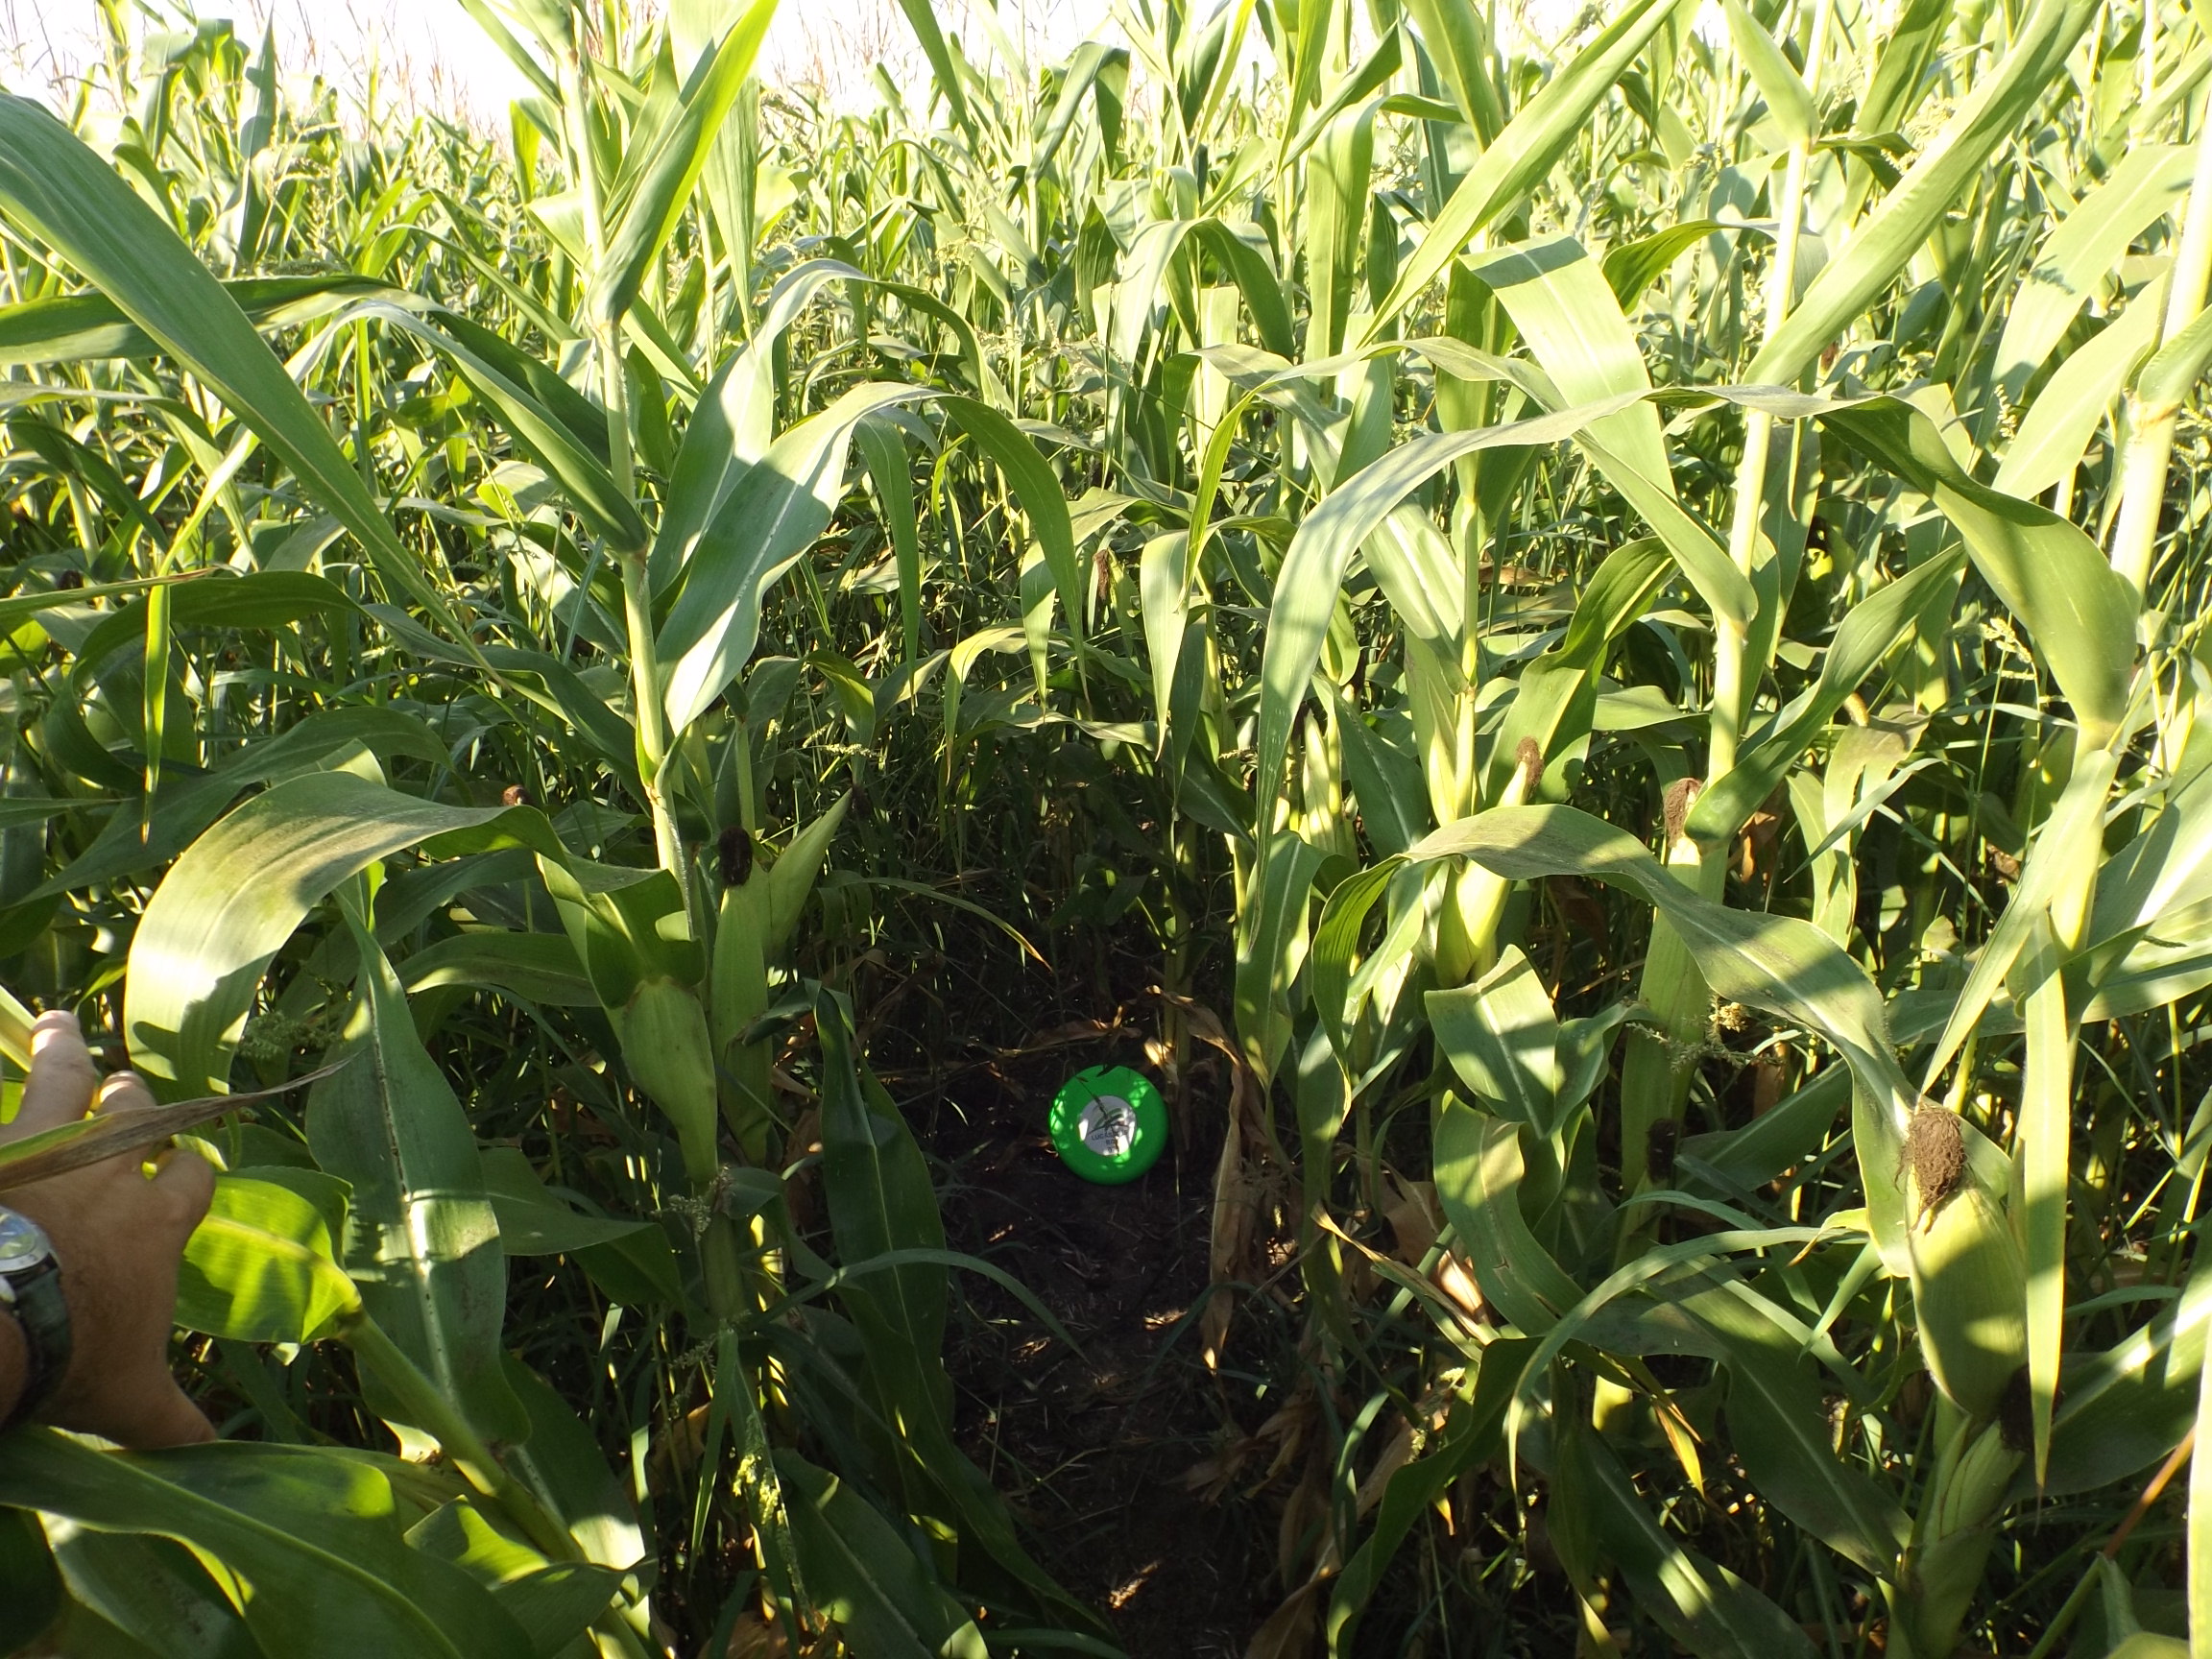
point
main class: Cropland
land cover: Maize
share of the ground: > 75 %
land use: Agriculture (excluding fallow land and kitchen gardens)
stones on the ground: < 10 %
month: August
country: BG
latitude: 43.3209
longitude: 27.9605
